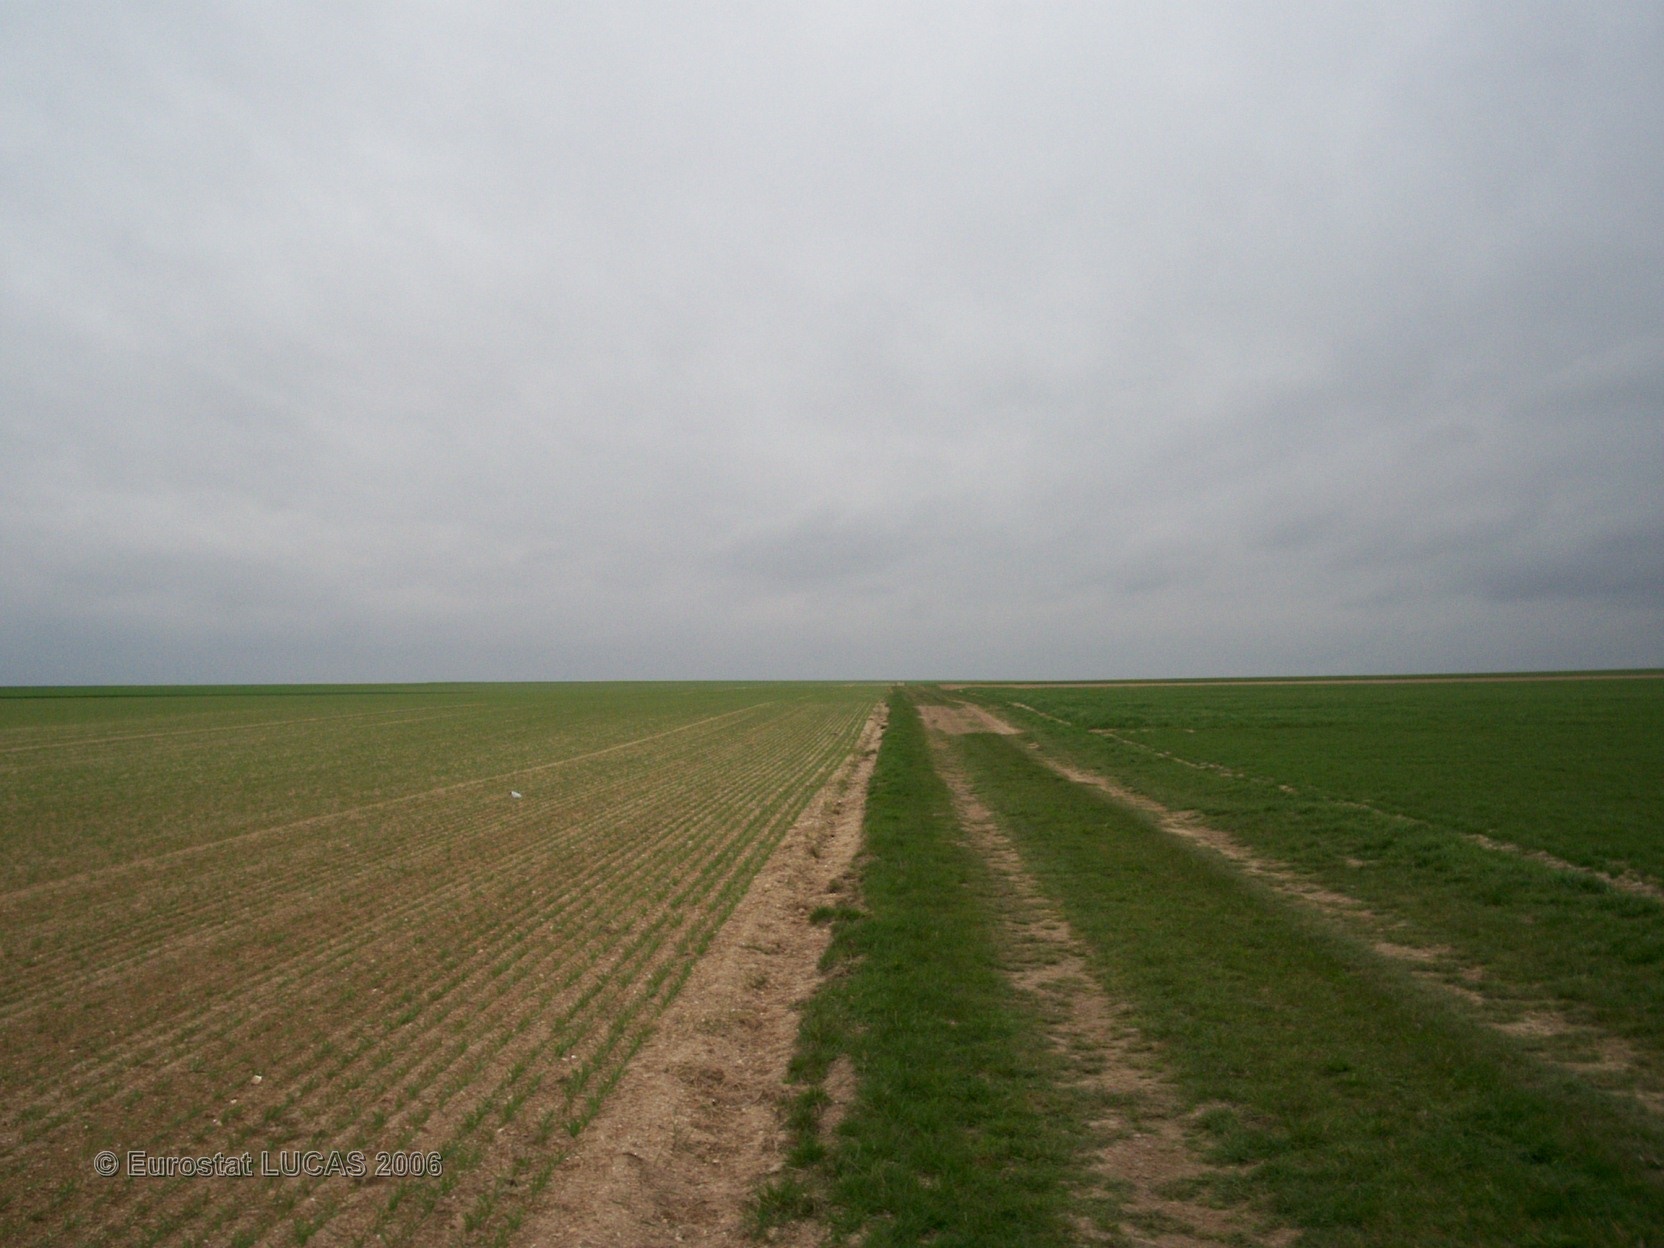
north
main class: Cropland
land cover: Barley
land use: Agriculture (excluding fallow land and kitchen gardens)
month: April
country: FR
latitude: 49.2191
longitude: 4.4359
